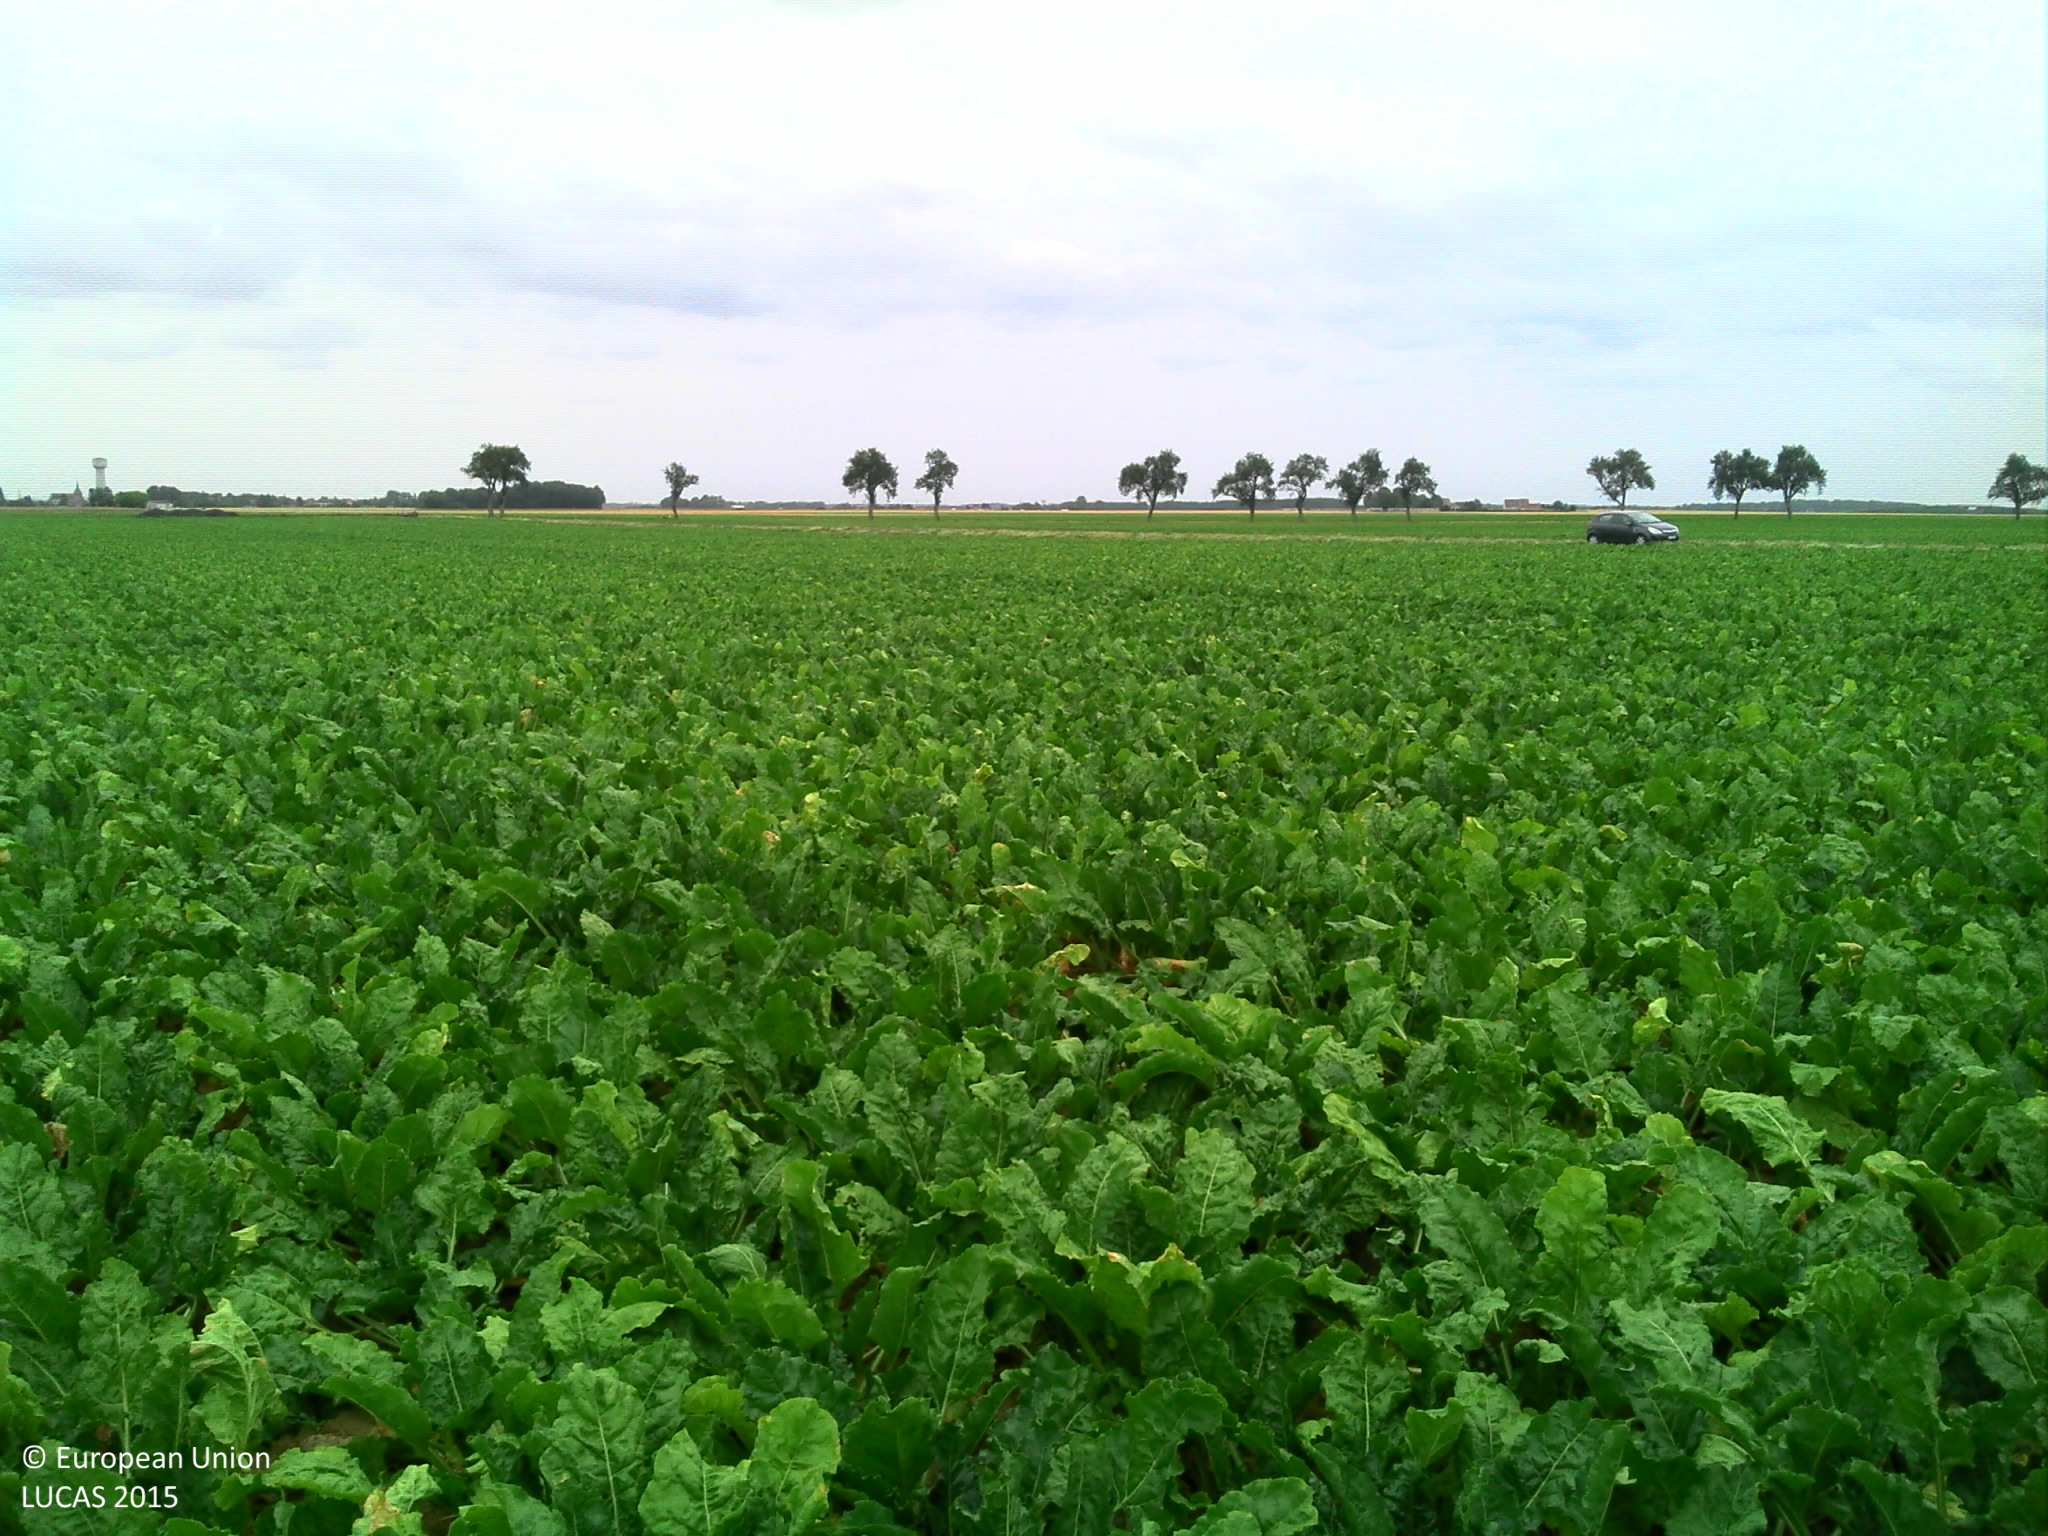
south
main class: Cropland
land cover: Sugar beet
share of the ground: > 75 %
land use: Agriculture (excluding fallow land and kitchen gardens)
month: July
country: FR
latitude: 48.6159
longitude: 2.7333
